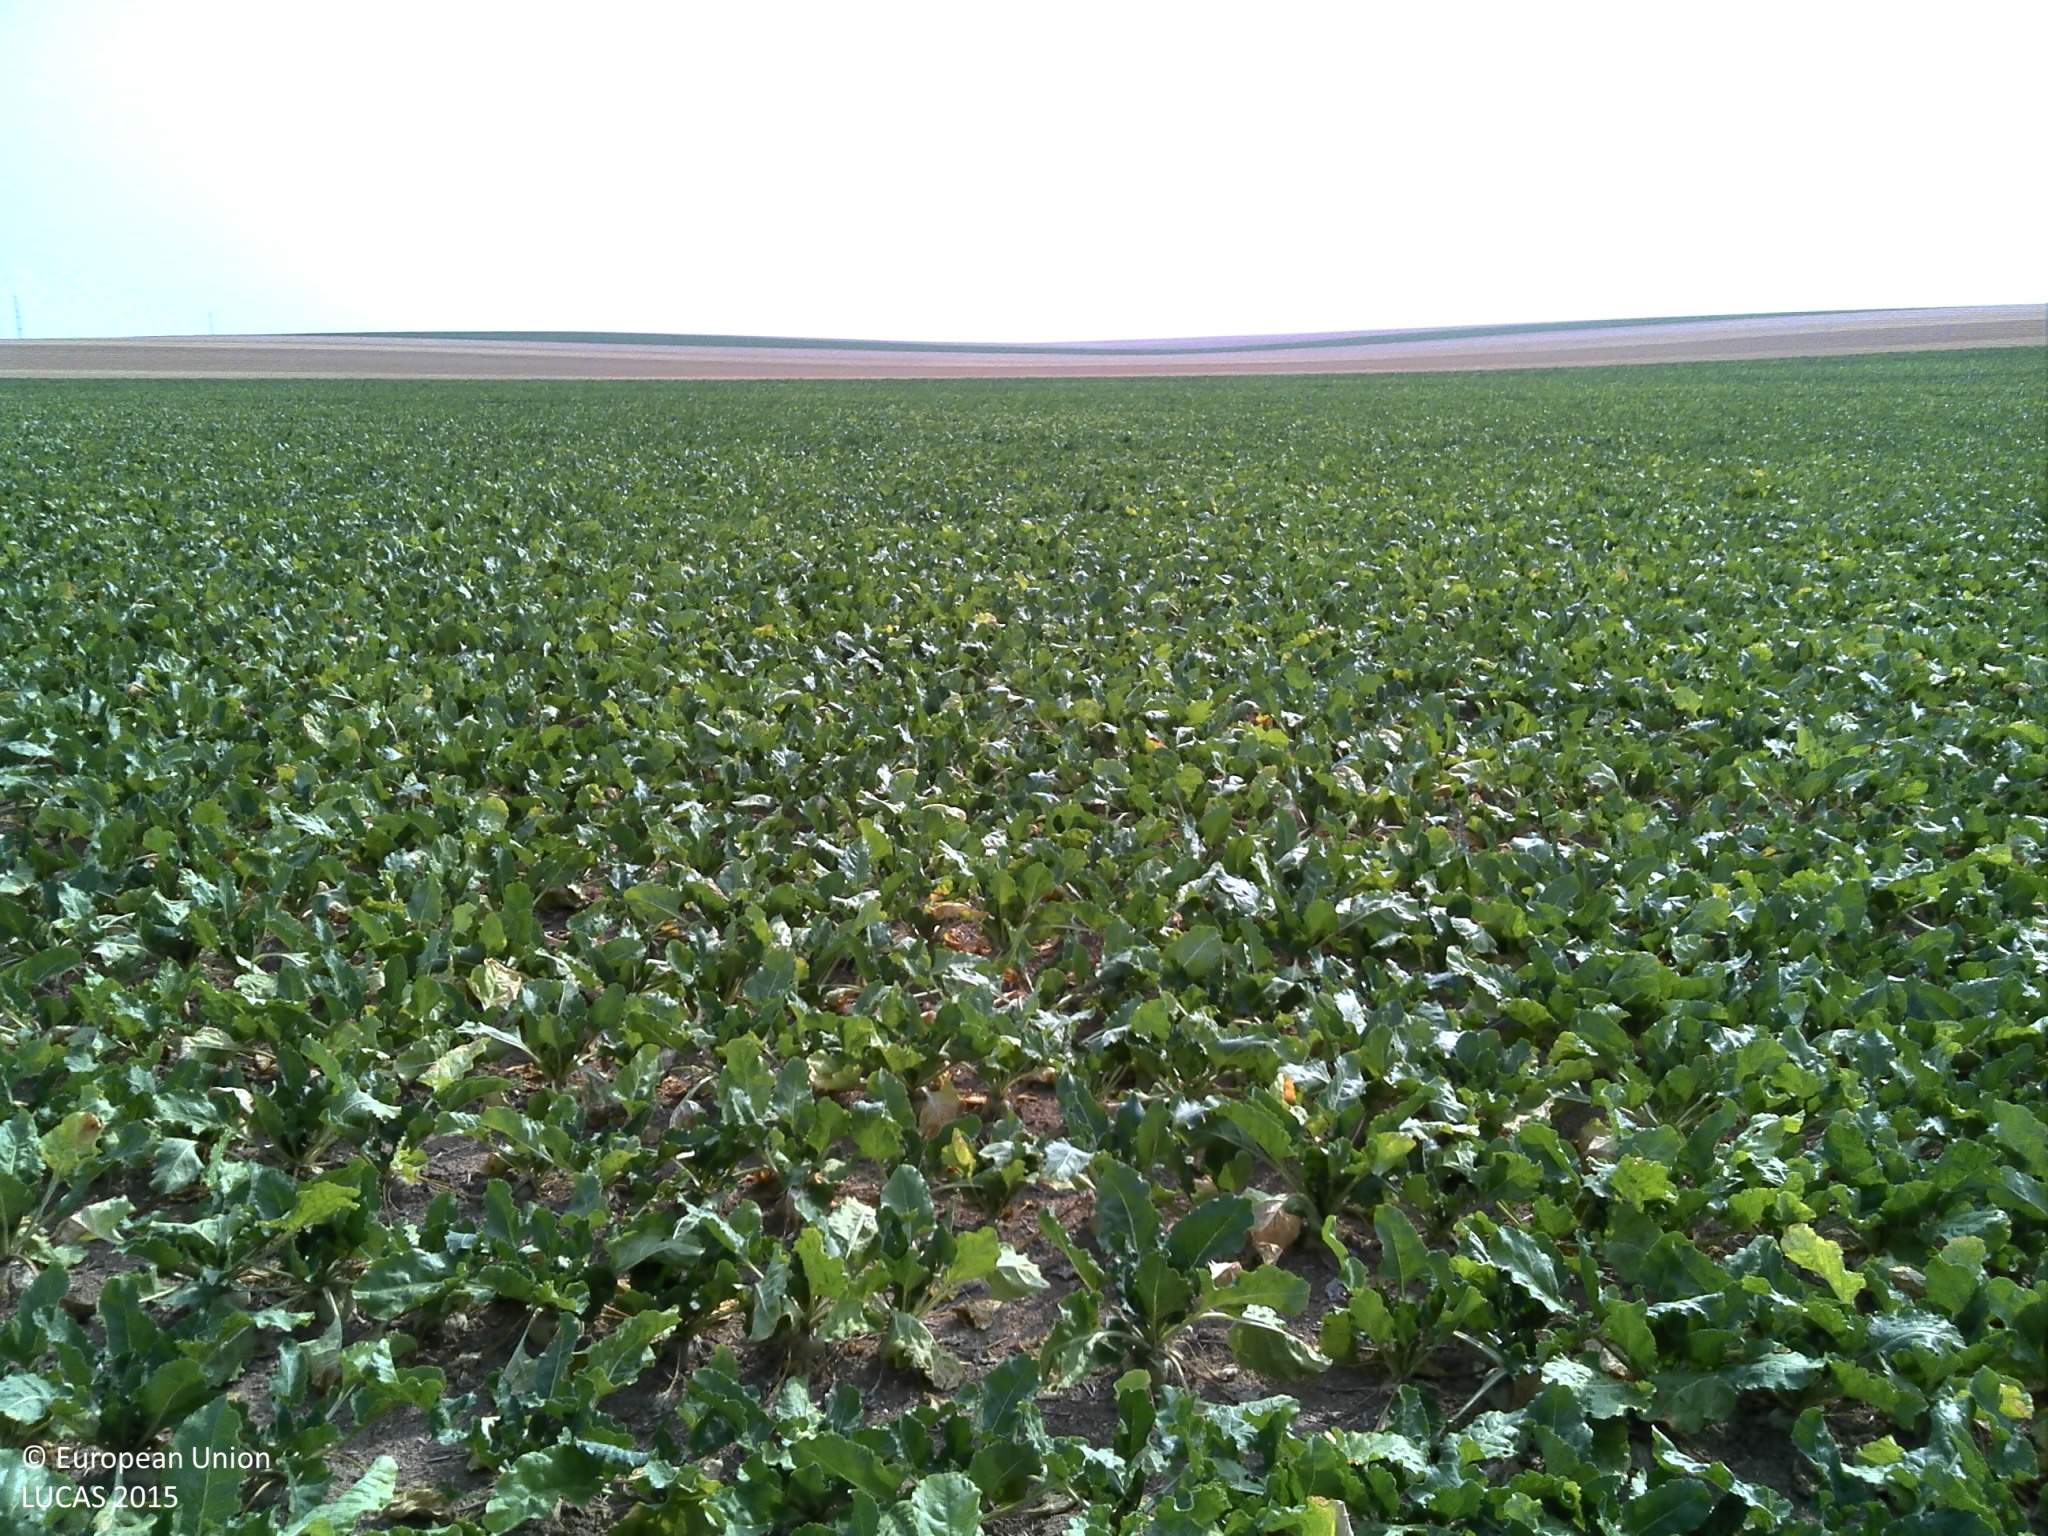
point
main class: Cropland
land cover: Sugar beet
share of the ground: 50 - 75 %
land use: Agriculture (excluding fallow land and kitchen gardens)
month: August
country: FR
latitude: 49.0299
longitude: 4.6219
